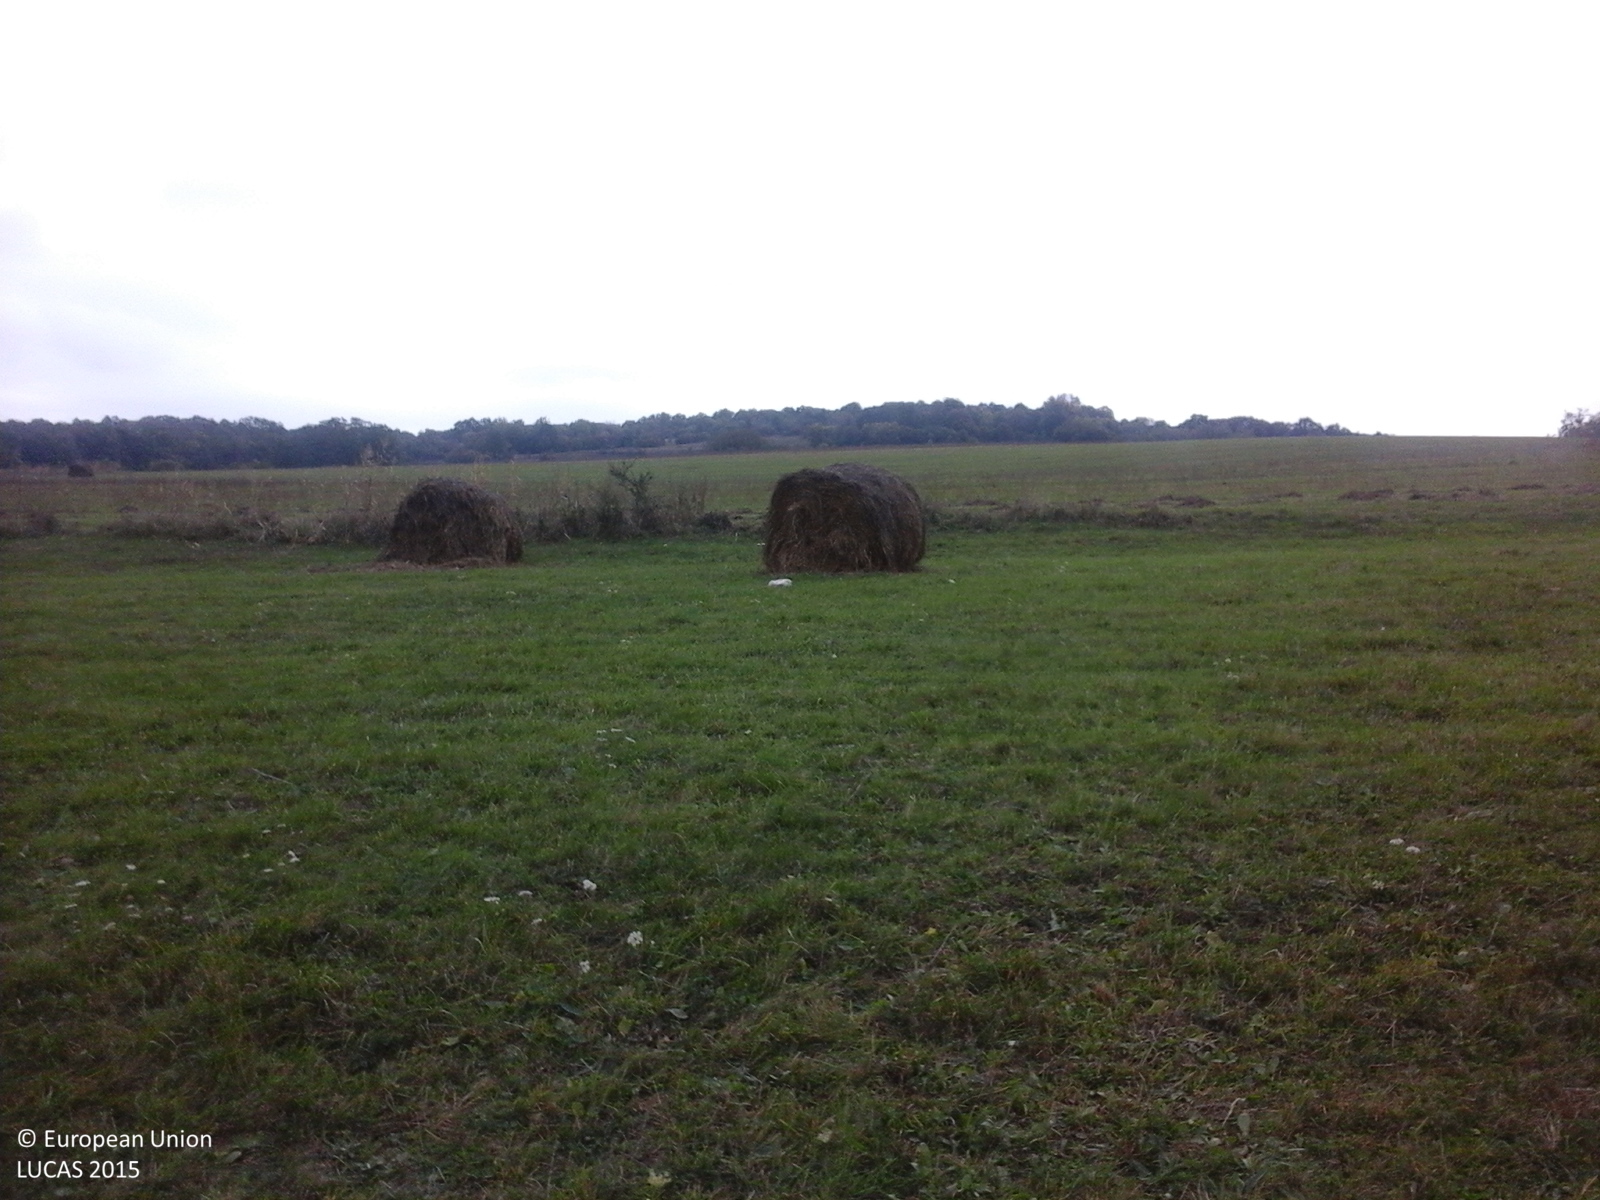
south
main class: Grassland
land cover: Grassland without tree/shrub cover
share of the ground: > 75 %
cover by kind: herbaceous plants 100 %
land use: Agriculture (excluding fallow land and kitchen gardens)
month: October
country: RO
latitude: 45.9077
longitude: 24.8763
